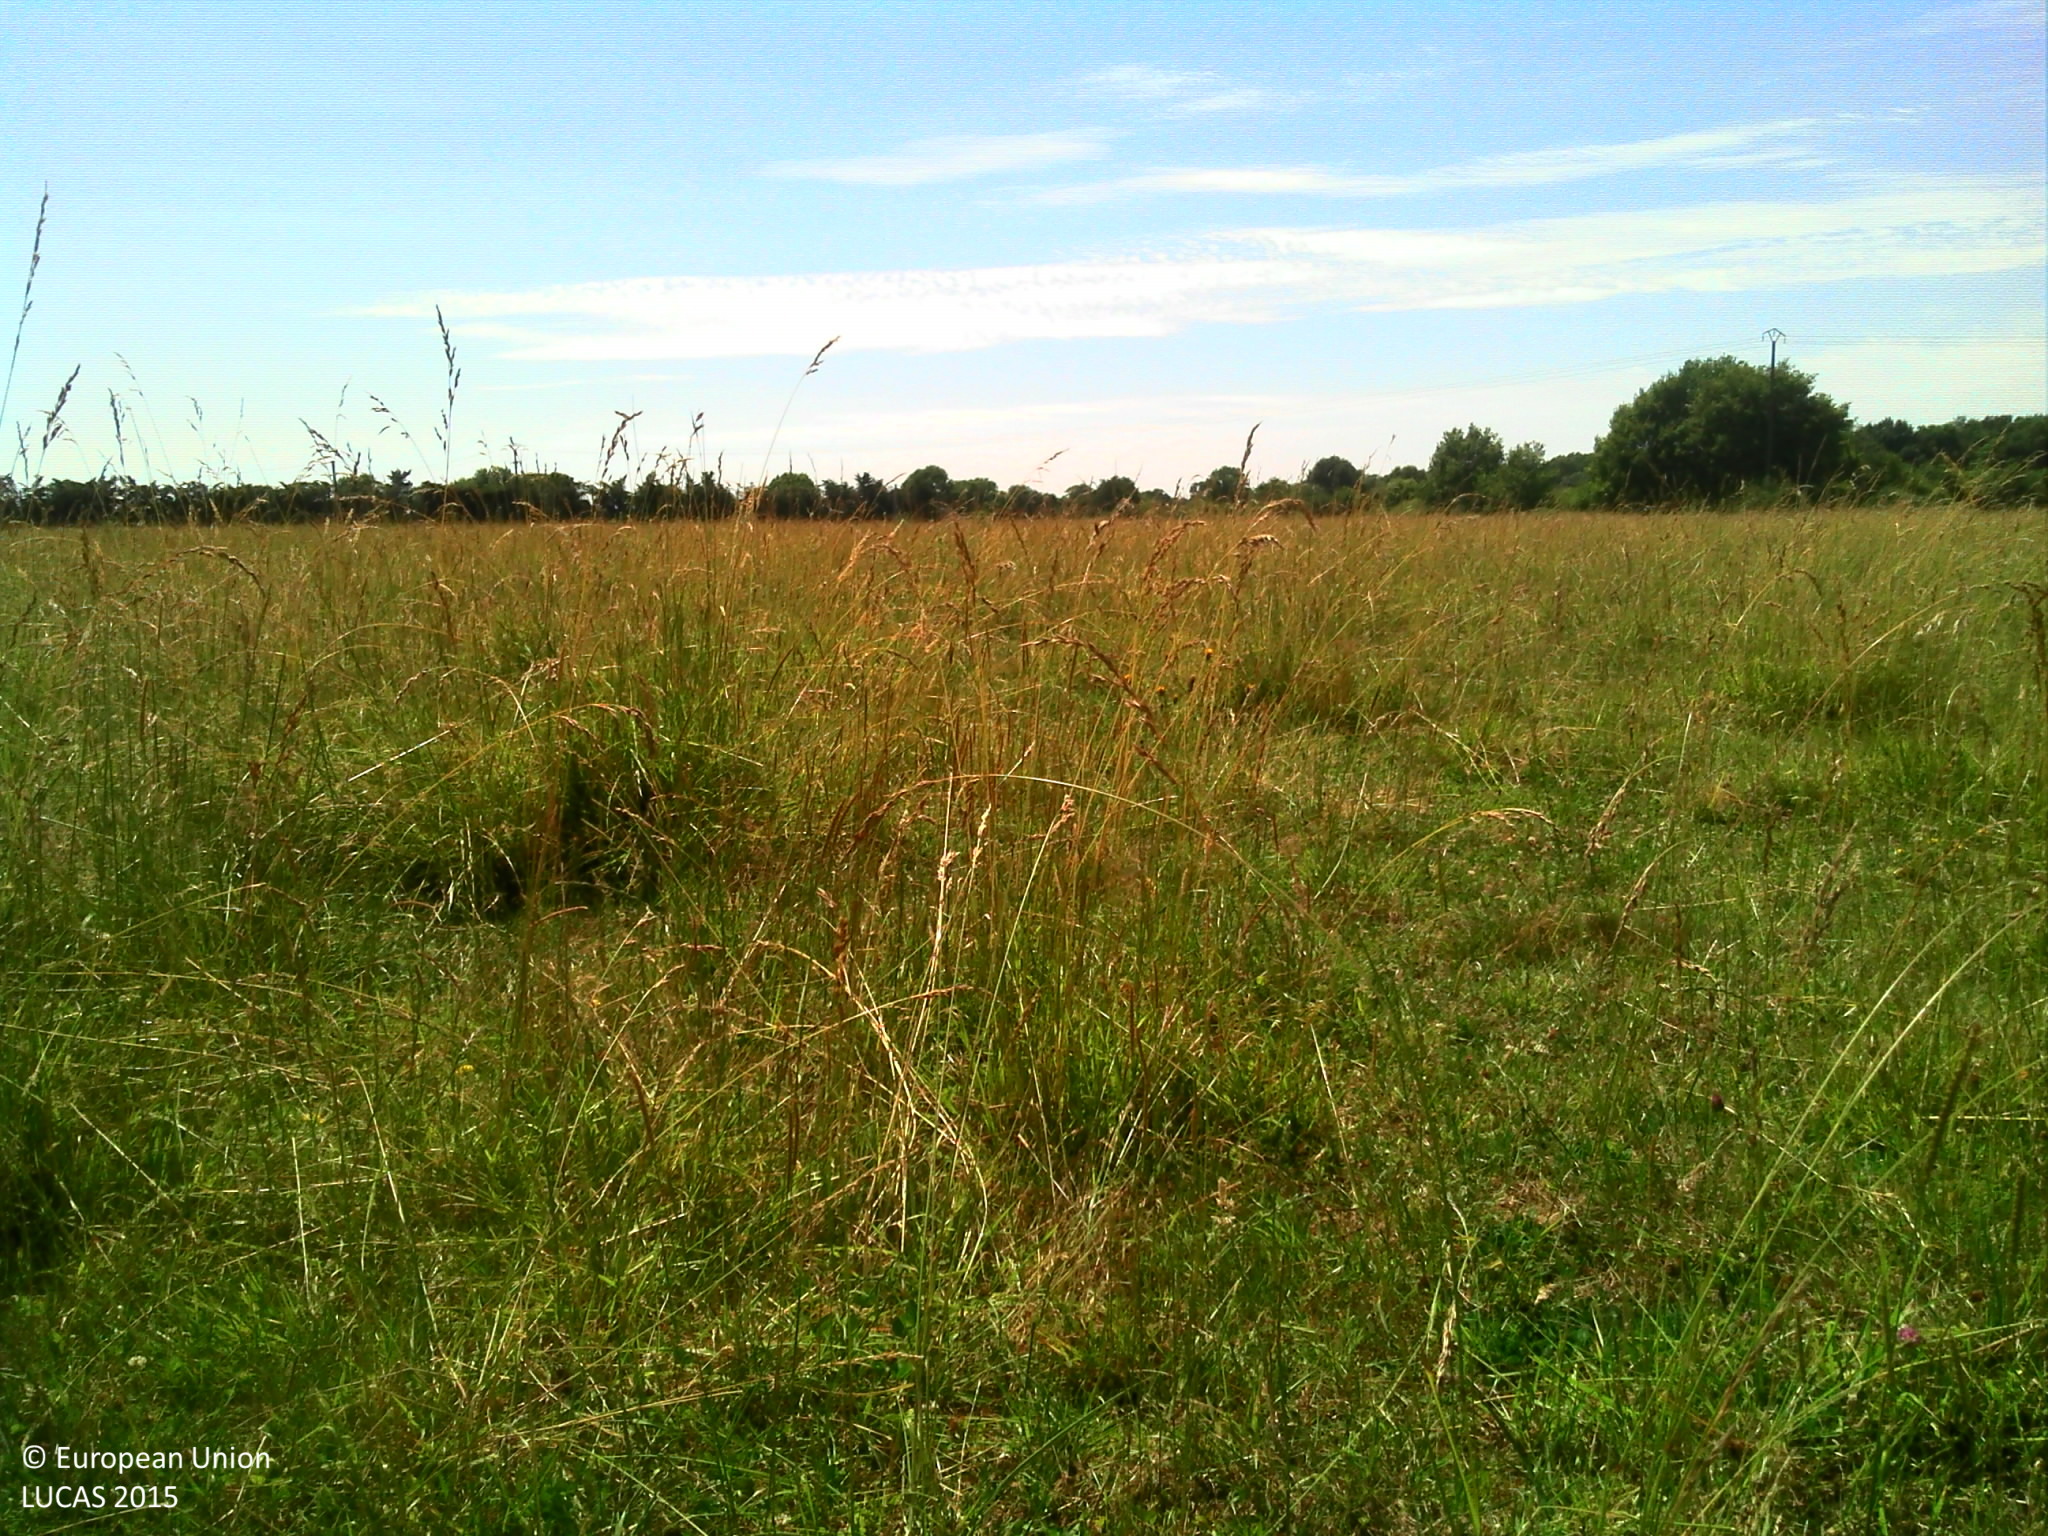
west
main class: Grassland
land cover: Grassland without tree/shrub cover
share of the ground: > 75 %
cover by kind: herbaceous plants 100 %
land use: Agriculture (excluding fallow land and kitchen gardens)
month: June
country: FR
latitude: 47.5071
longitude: 0.3246
